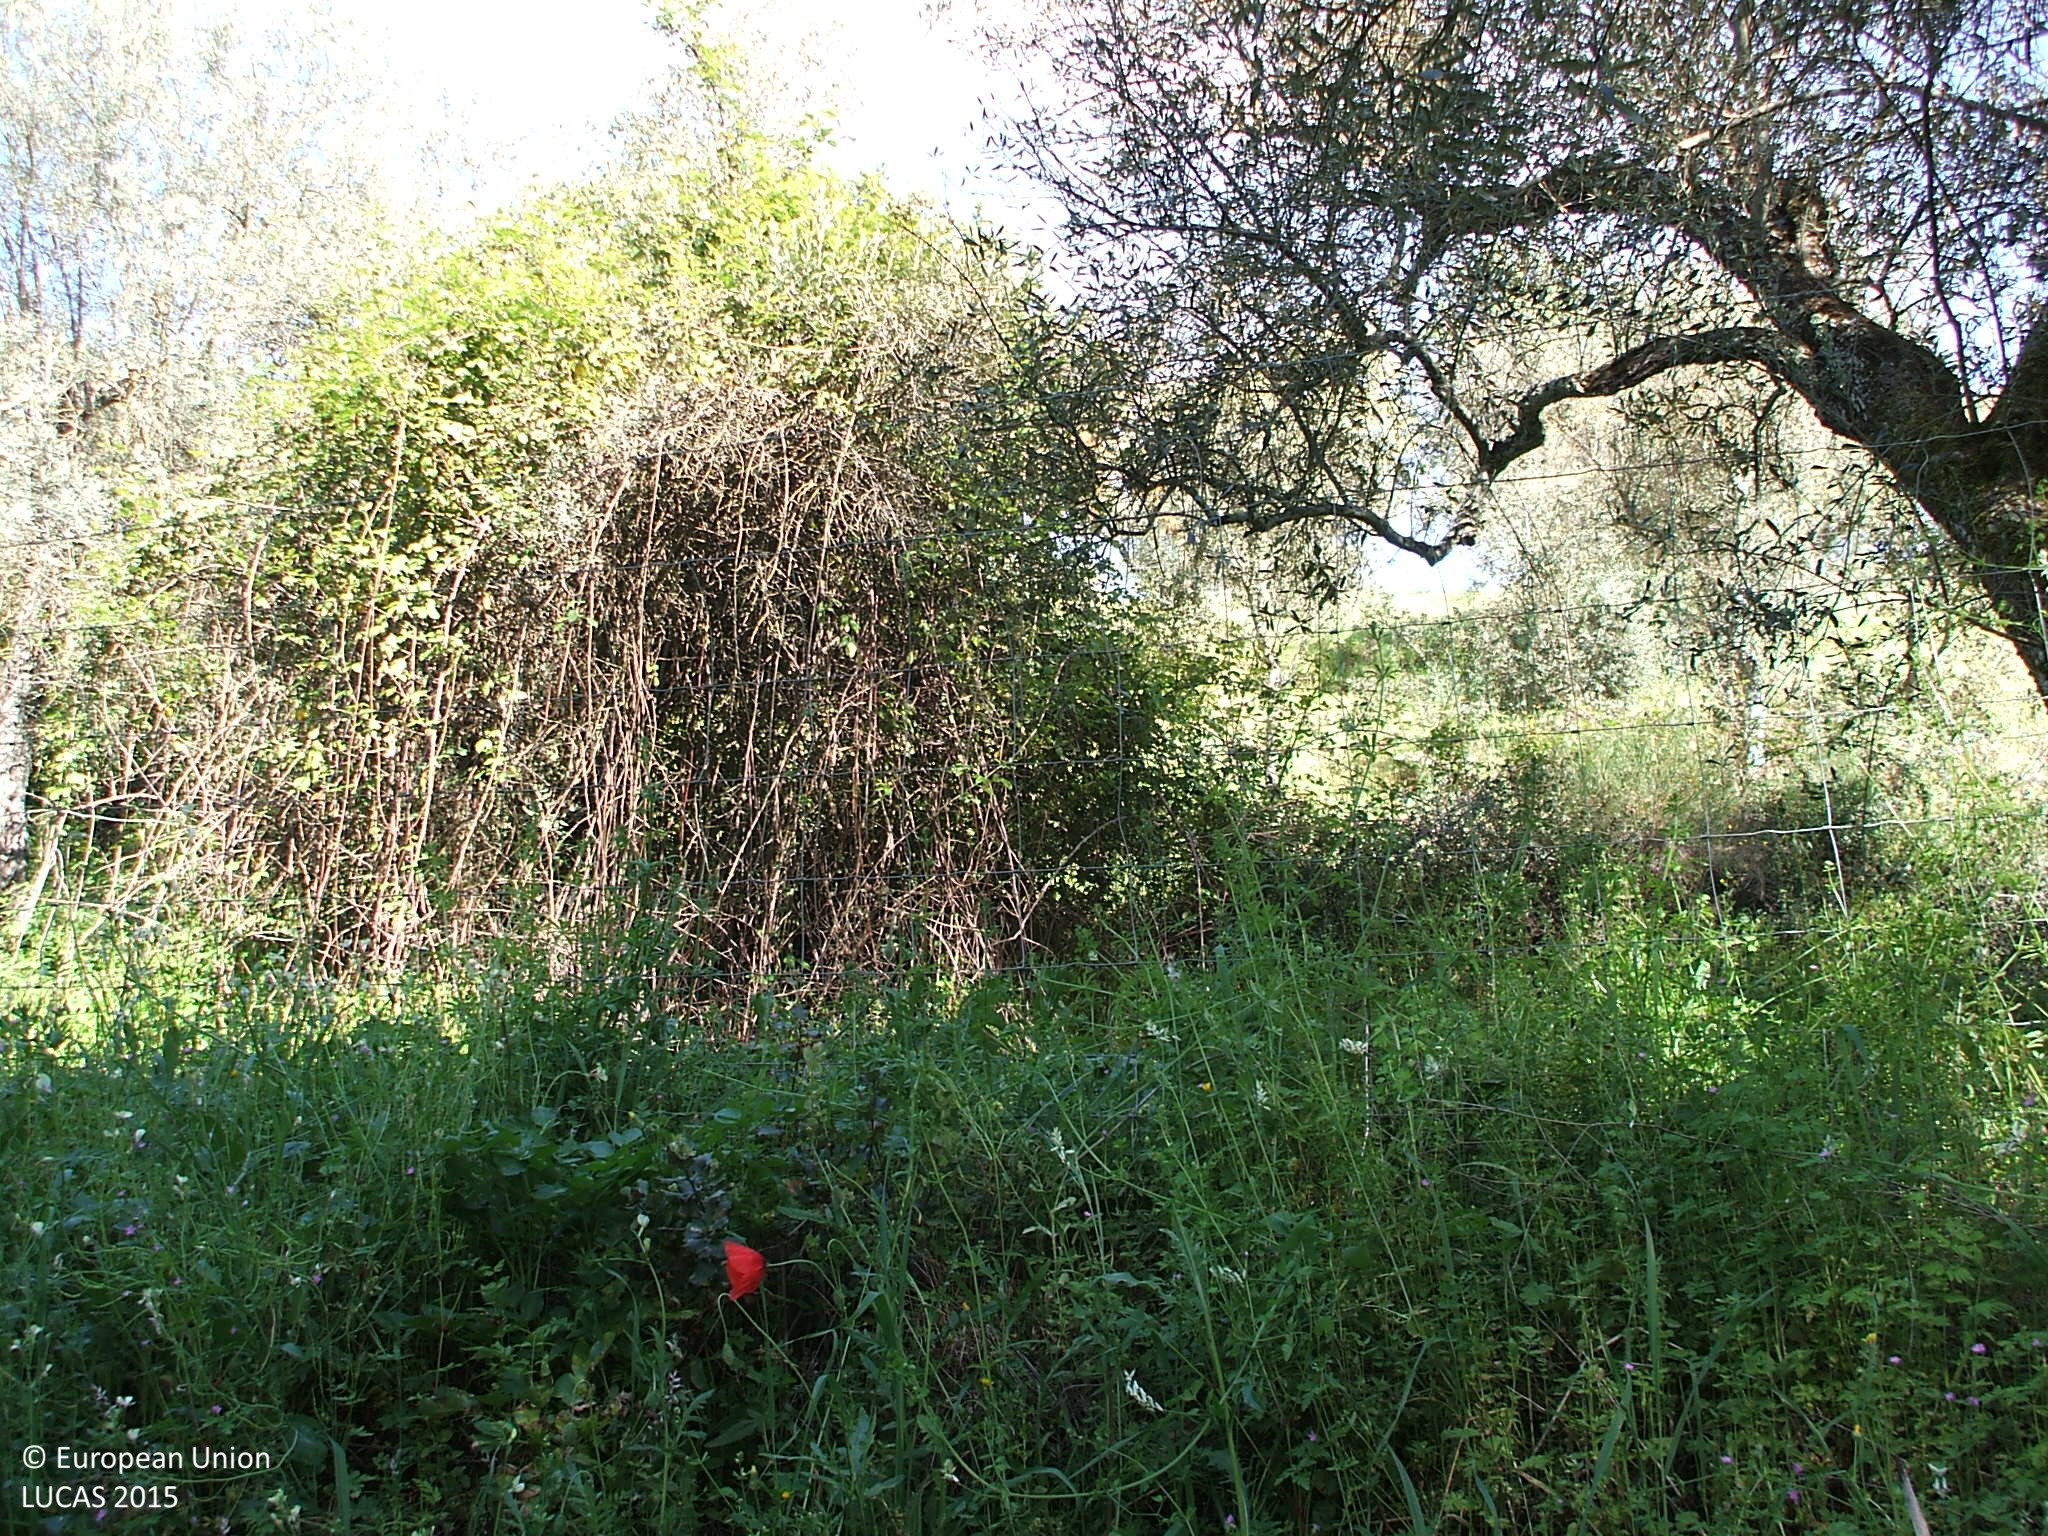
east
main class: Cropland
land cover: Olive groves
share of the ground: 25 - 50 %
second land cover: Grassland without tree/shrub cover
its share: > 75 %
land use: Agriculture (excluding fallow land and kitchen gardens)
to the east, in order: Olive groves; Grassland without tree/shrub cover; Artificial constructions in urban areas; Permanent crops (only in case pi); Tracks; Grassland without tree/shrub cover; Permanent crops (only in case pi); Fences; Permanent crops (only in case pi); Broadleaved woodland
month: April
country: ES
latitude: 38.0342
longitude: -5.7195
